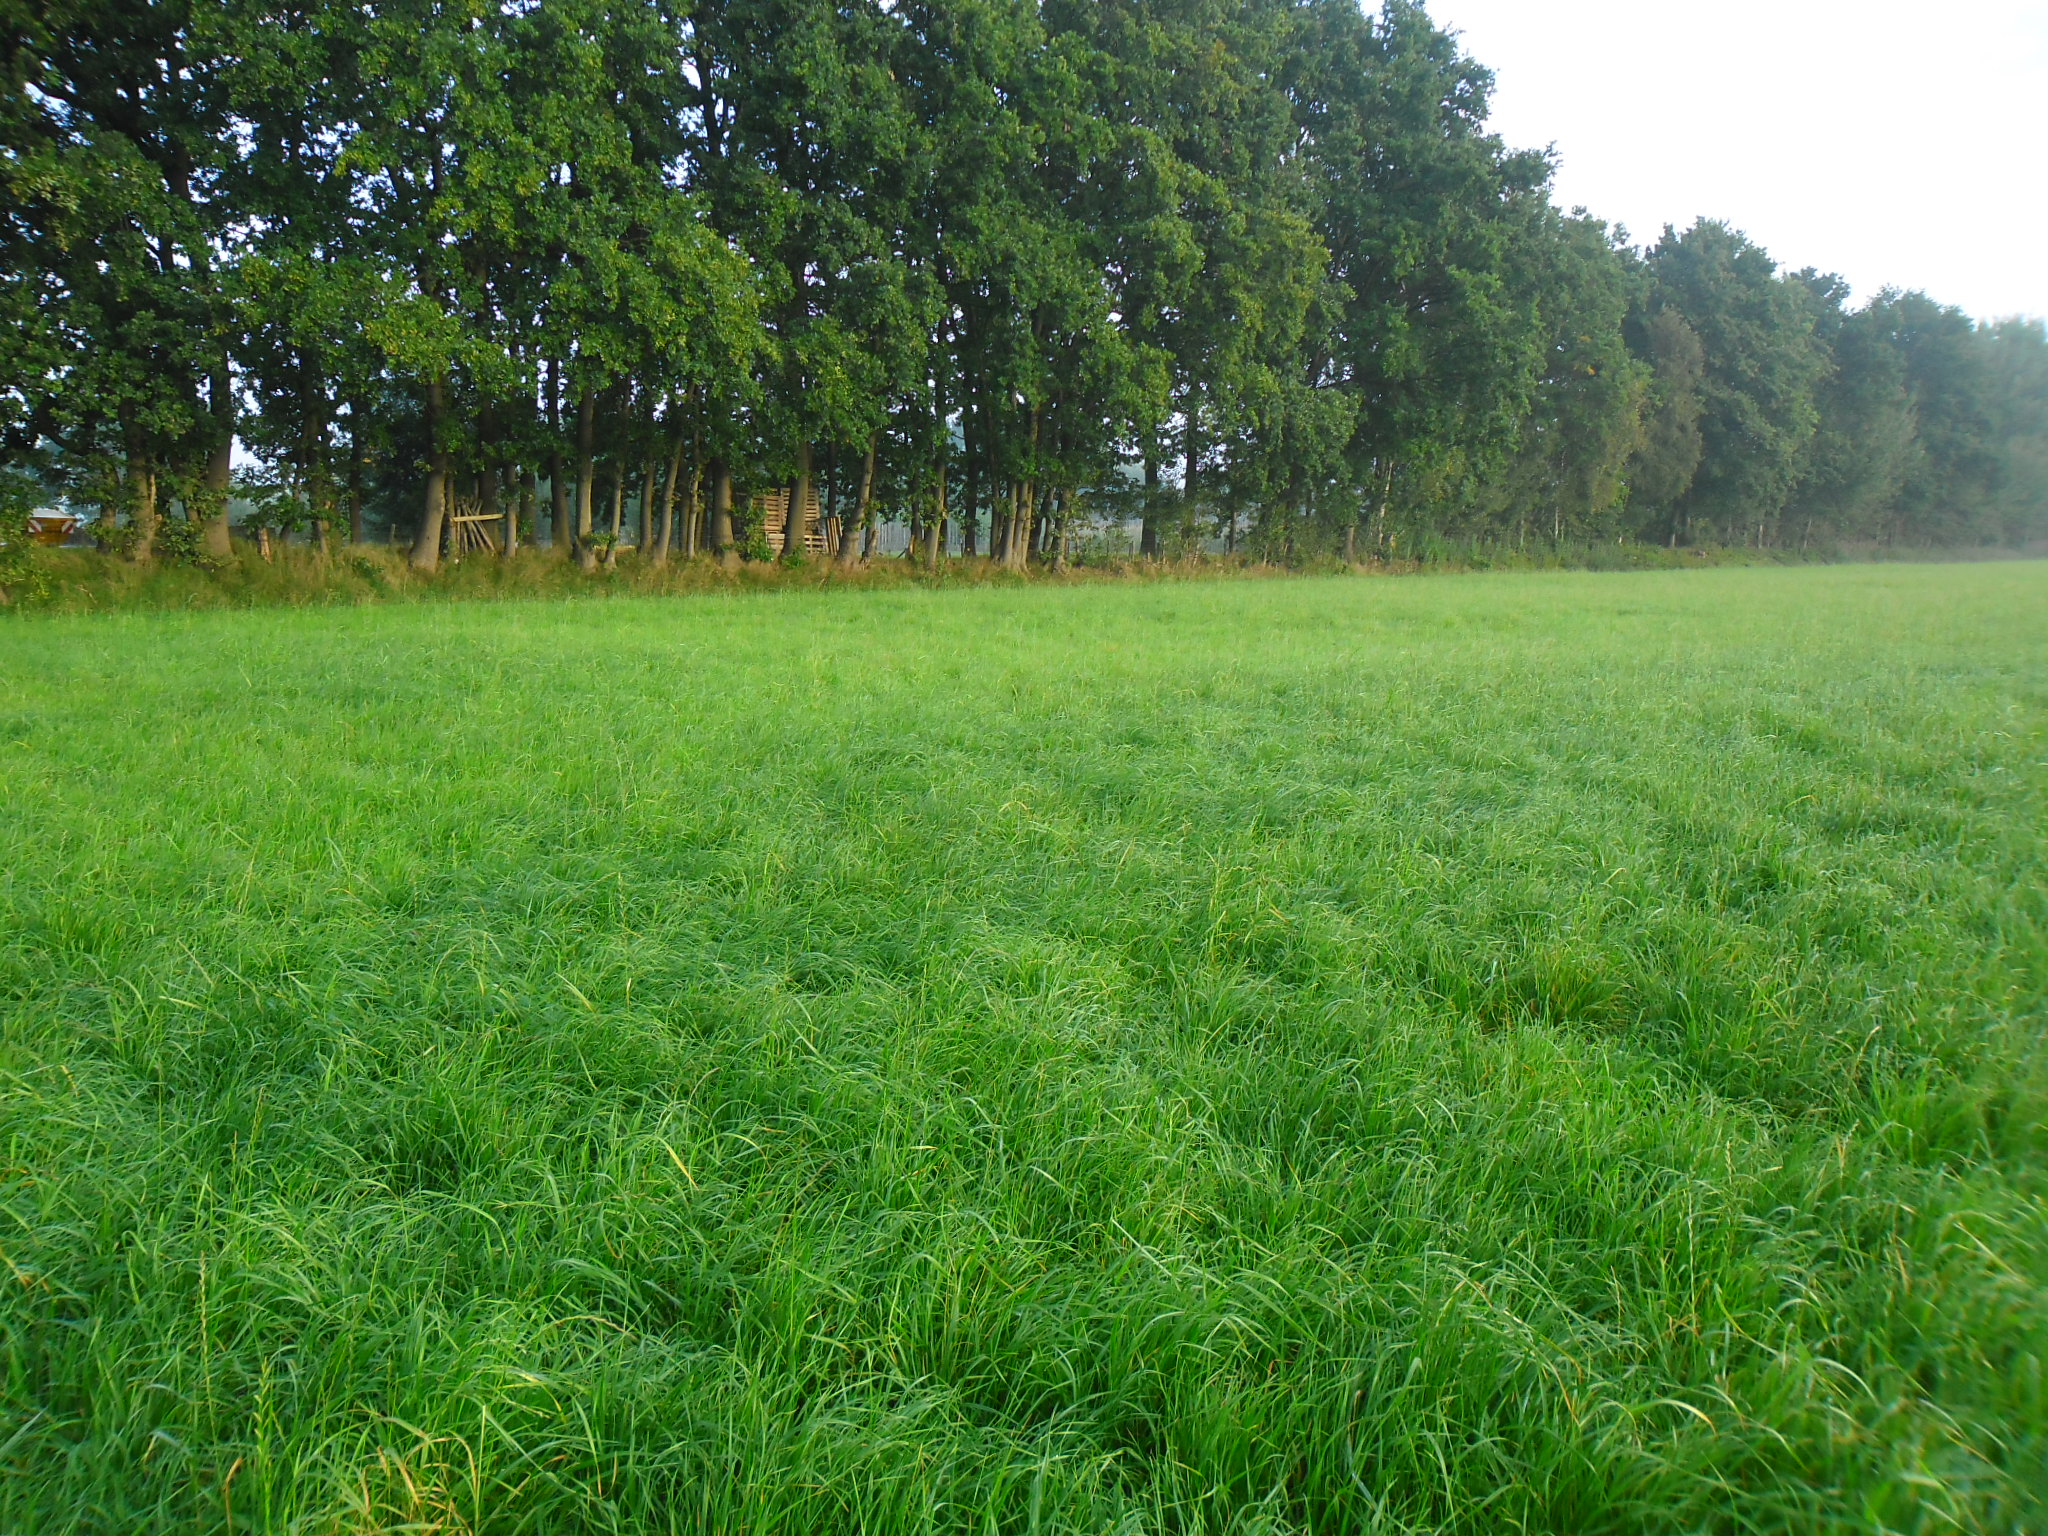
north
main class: Grassland
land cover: Grassland without tree/shrub cover
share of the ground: > 75 %
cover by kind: herbaceous plants 100 %
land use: Agriculture (excluding fallow land and kitchen gardens)
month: September
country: NL
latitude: 52.0590
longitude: 5.5207
